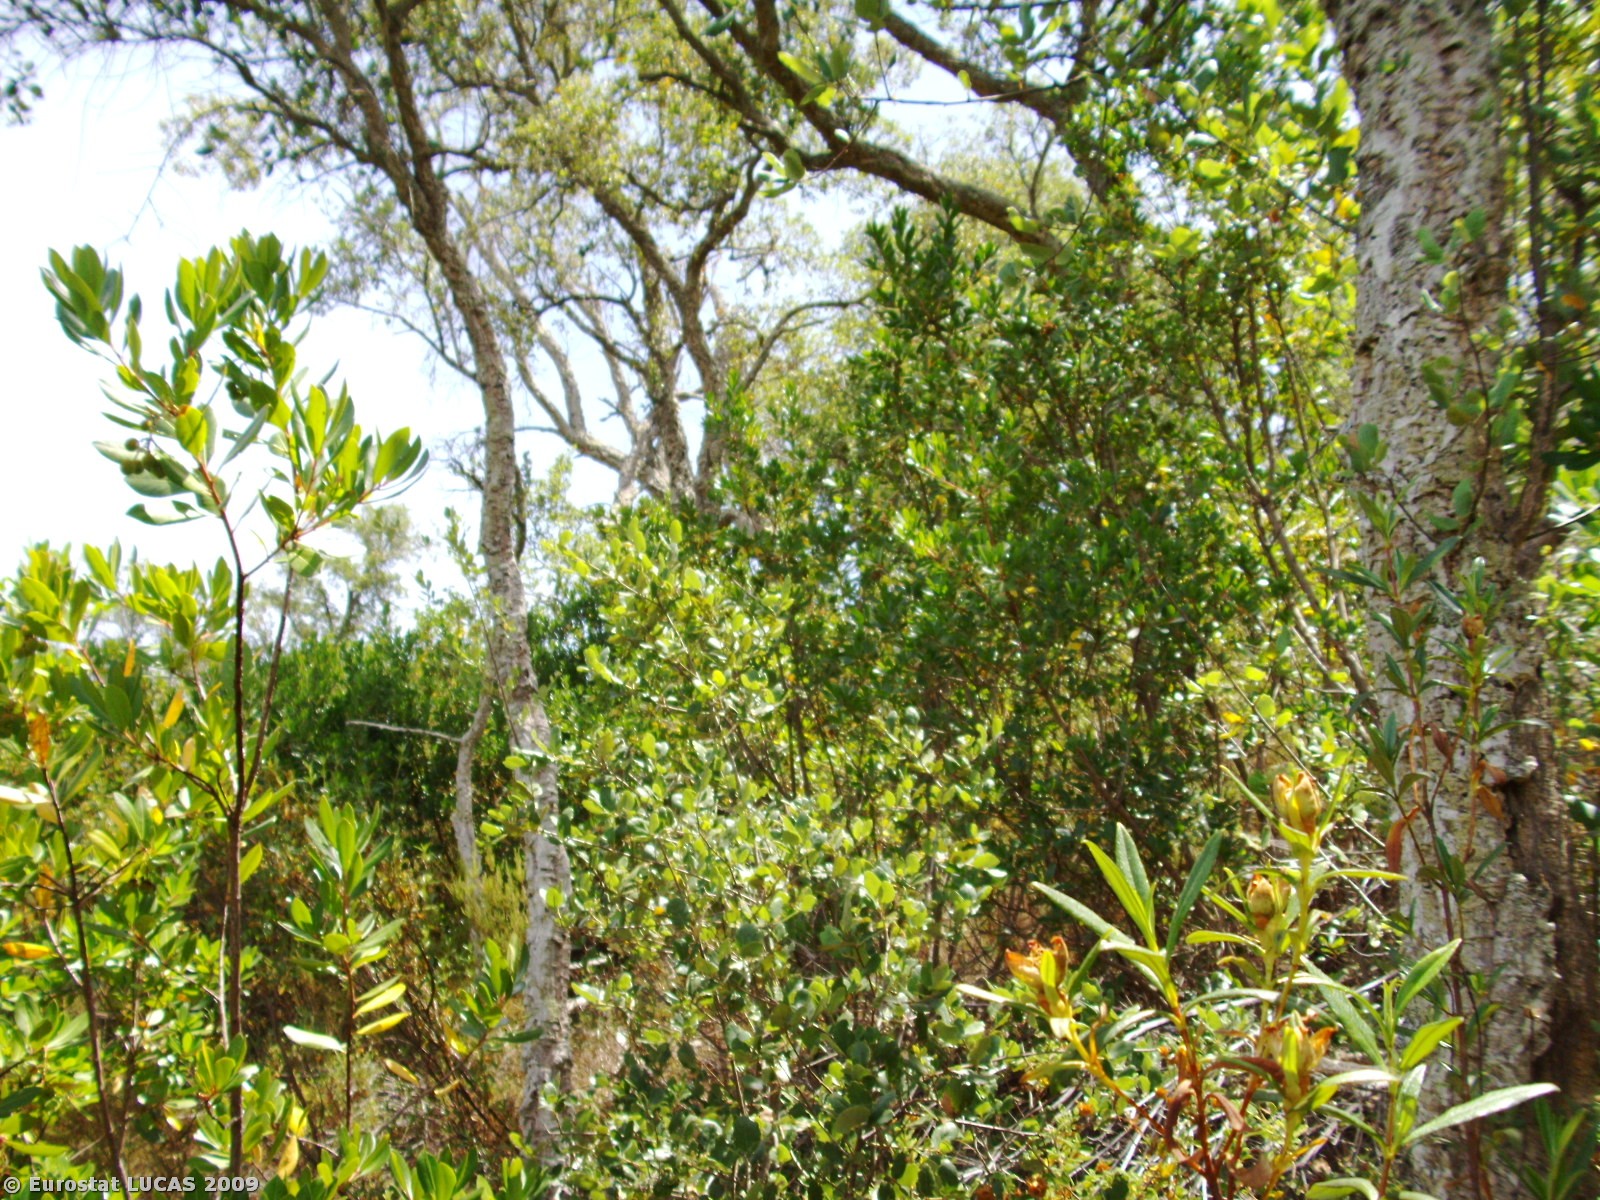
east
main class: Woodland
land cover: Broadleaved woodland
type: broadleaved evergreen forest
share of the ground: > 75 %
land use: Unused
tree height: > 5 m
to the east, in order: Shrubland with sparse tree cover; Grass margins; Bare land; Shrubland with sparse tree cover; Tracks; Shrubland with sparse tree cover
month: June
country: PT
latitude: 37.4684
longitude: -8.5188
